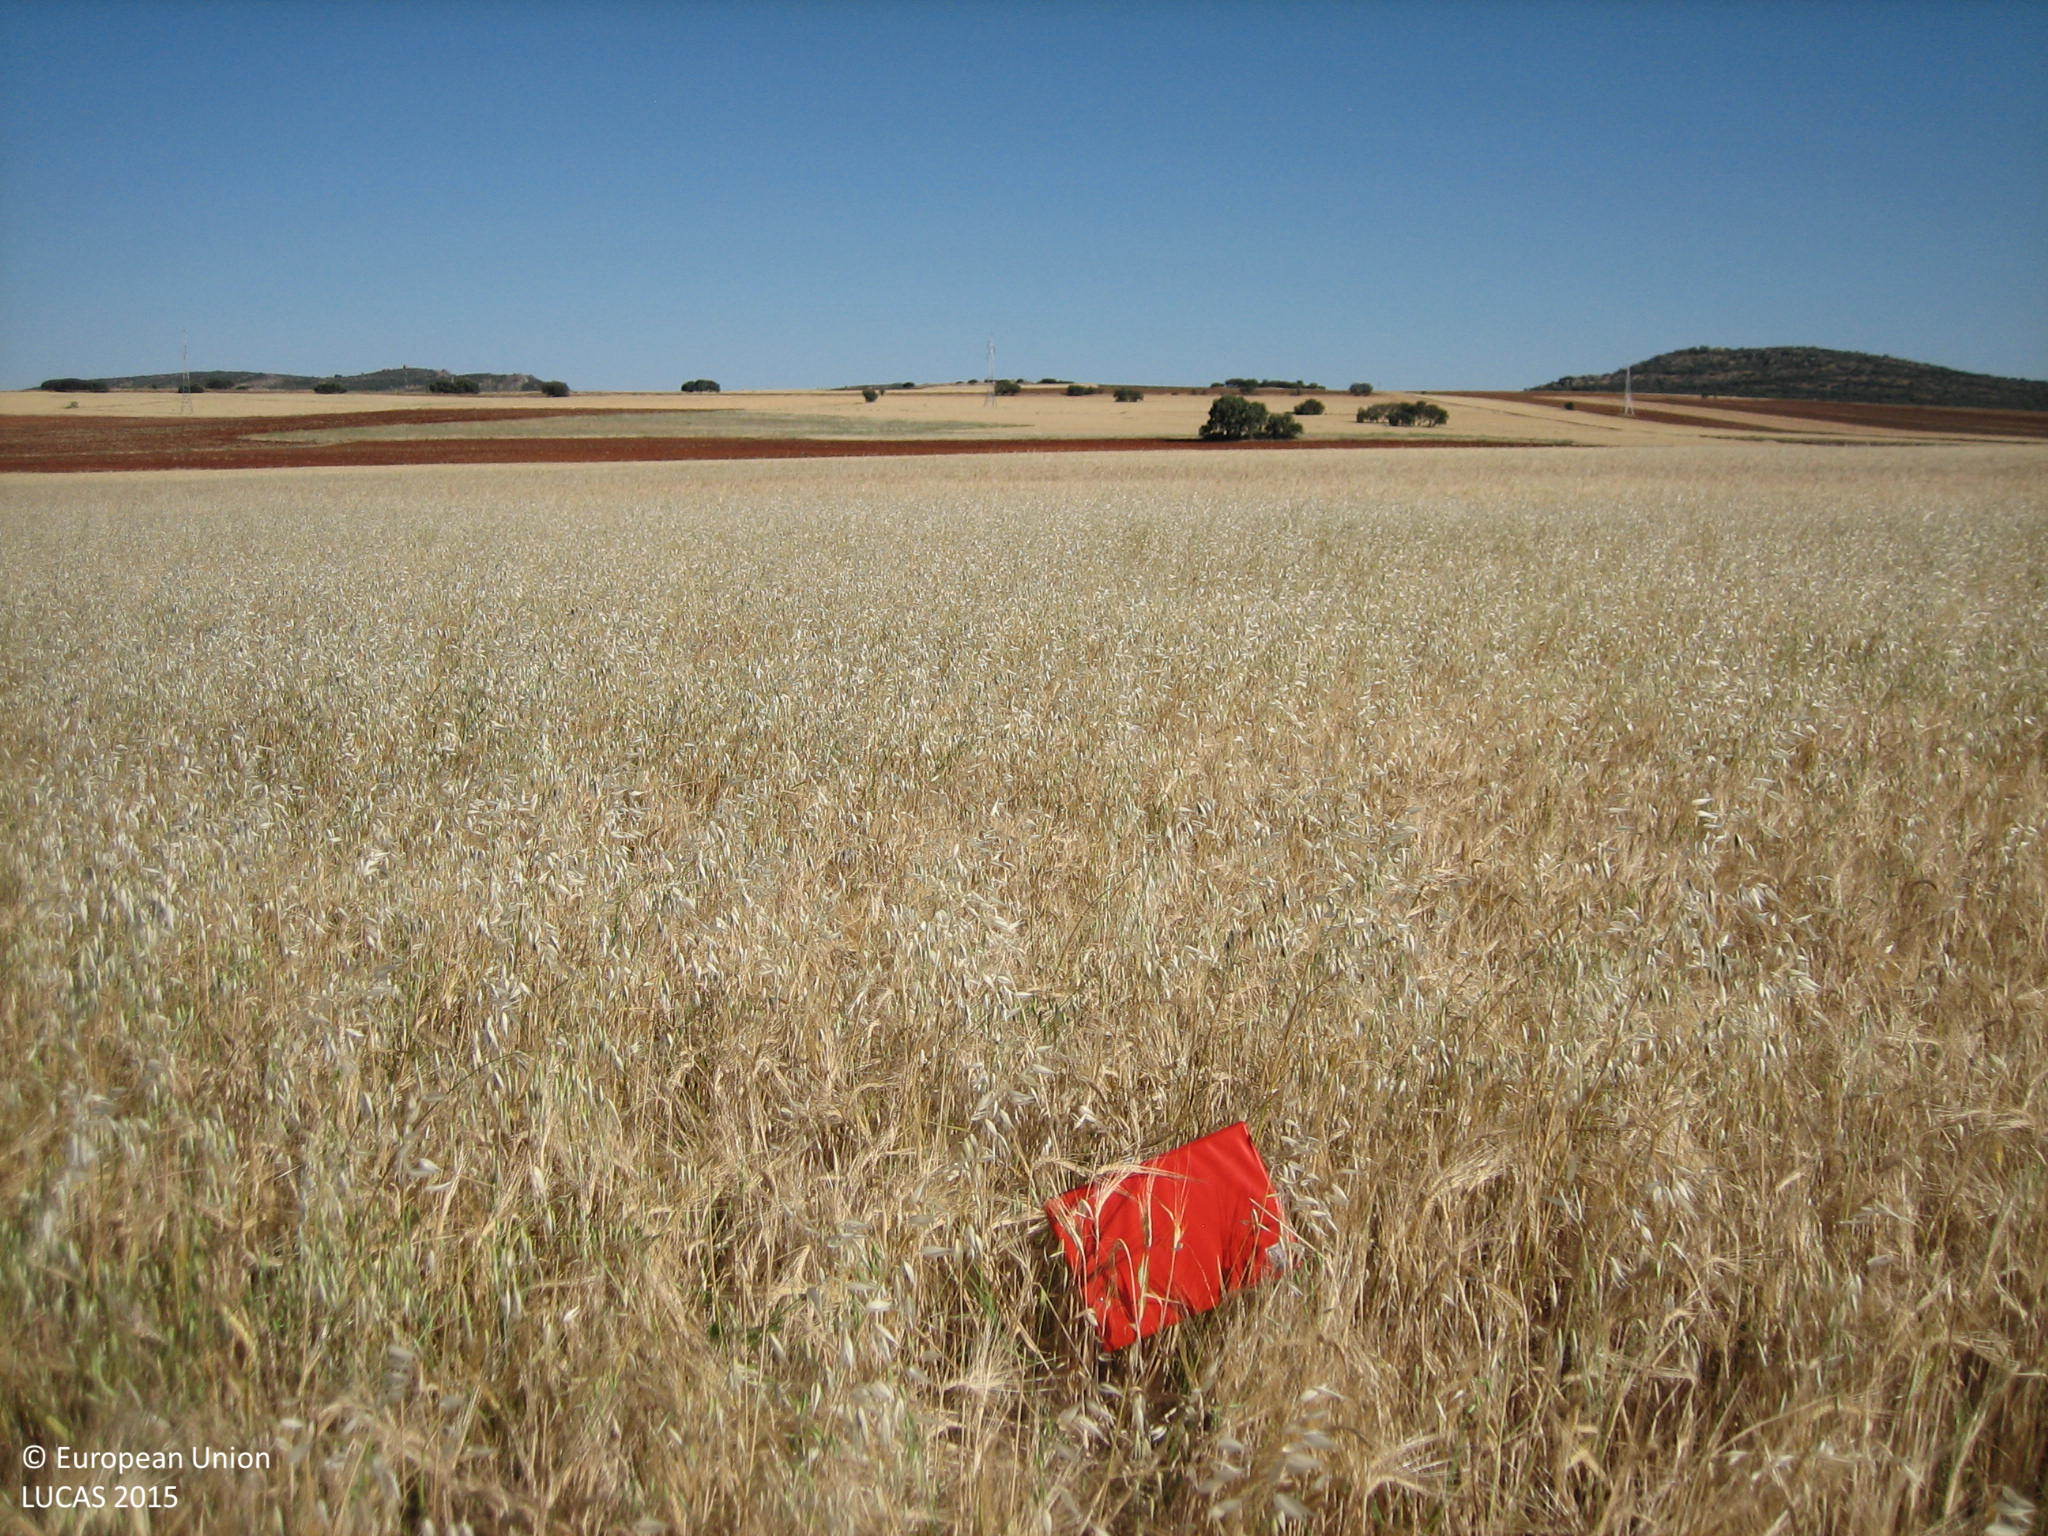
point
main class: Cropland
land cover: Barley
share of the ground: > 75 %
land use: Agriculture (excluding fallow land and kitchen gardens)
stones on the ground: < 10 %
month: June
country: ES
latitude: 38.8661
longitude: -4.0461
